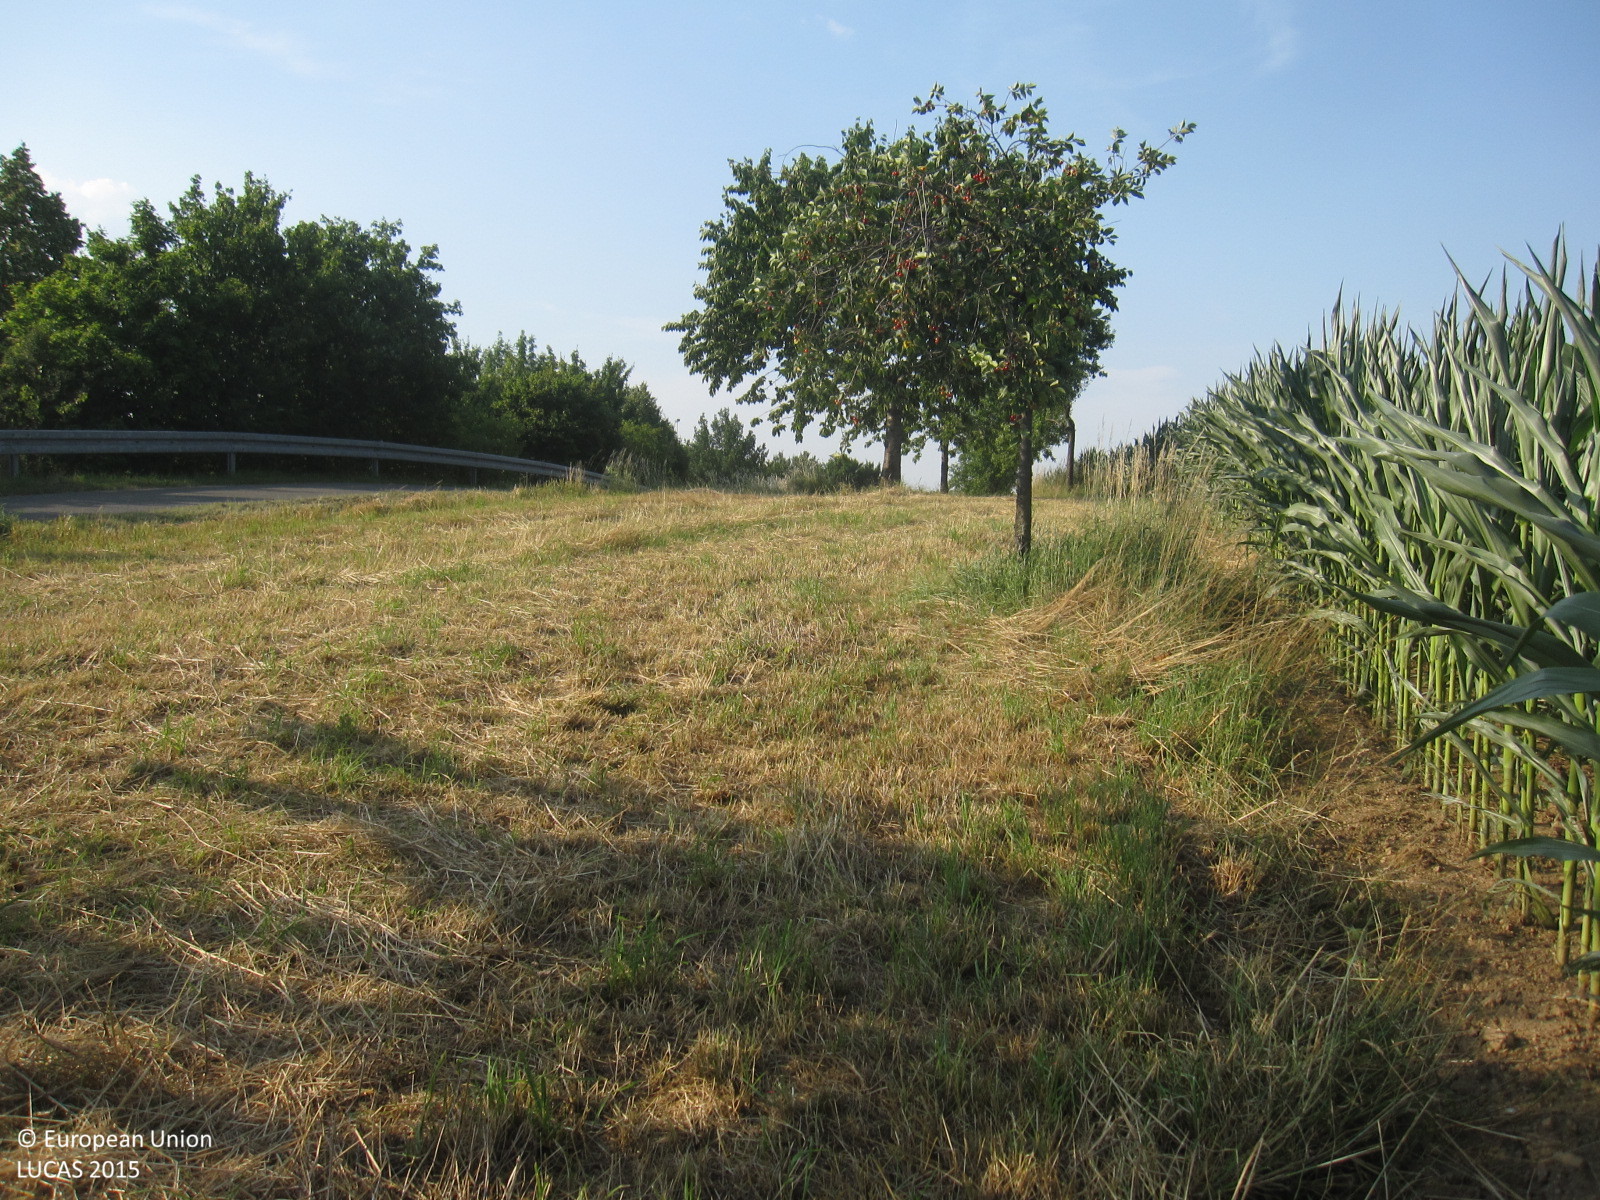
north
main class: Cropland
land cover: Maize
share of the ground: > 75 %
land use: Agriculture (excluding fallow land and kitchen gardens)
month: July
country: DE
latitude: 50.8661
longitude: 12.1168
